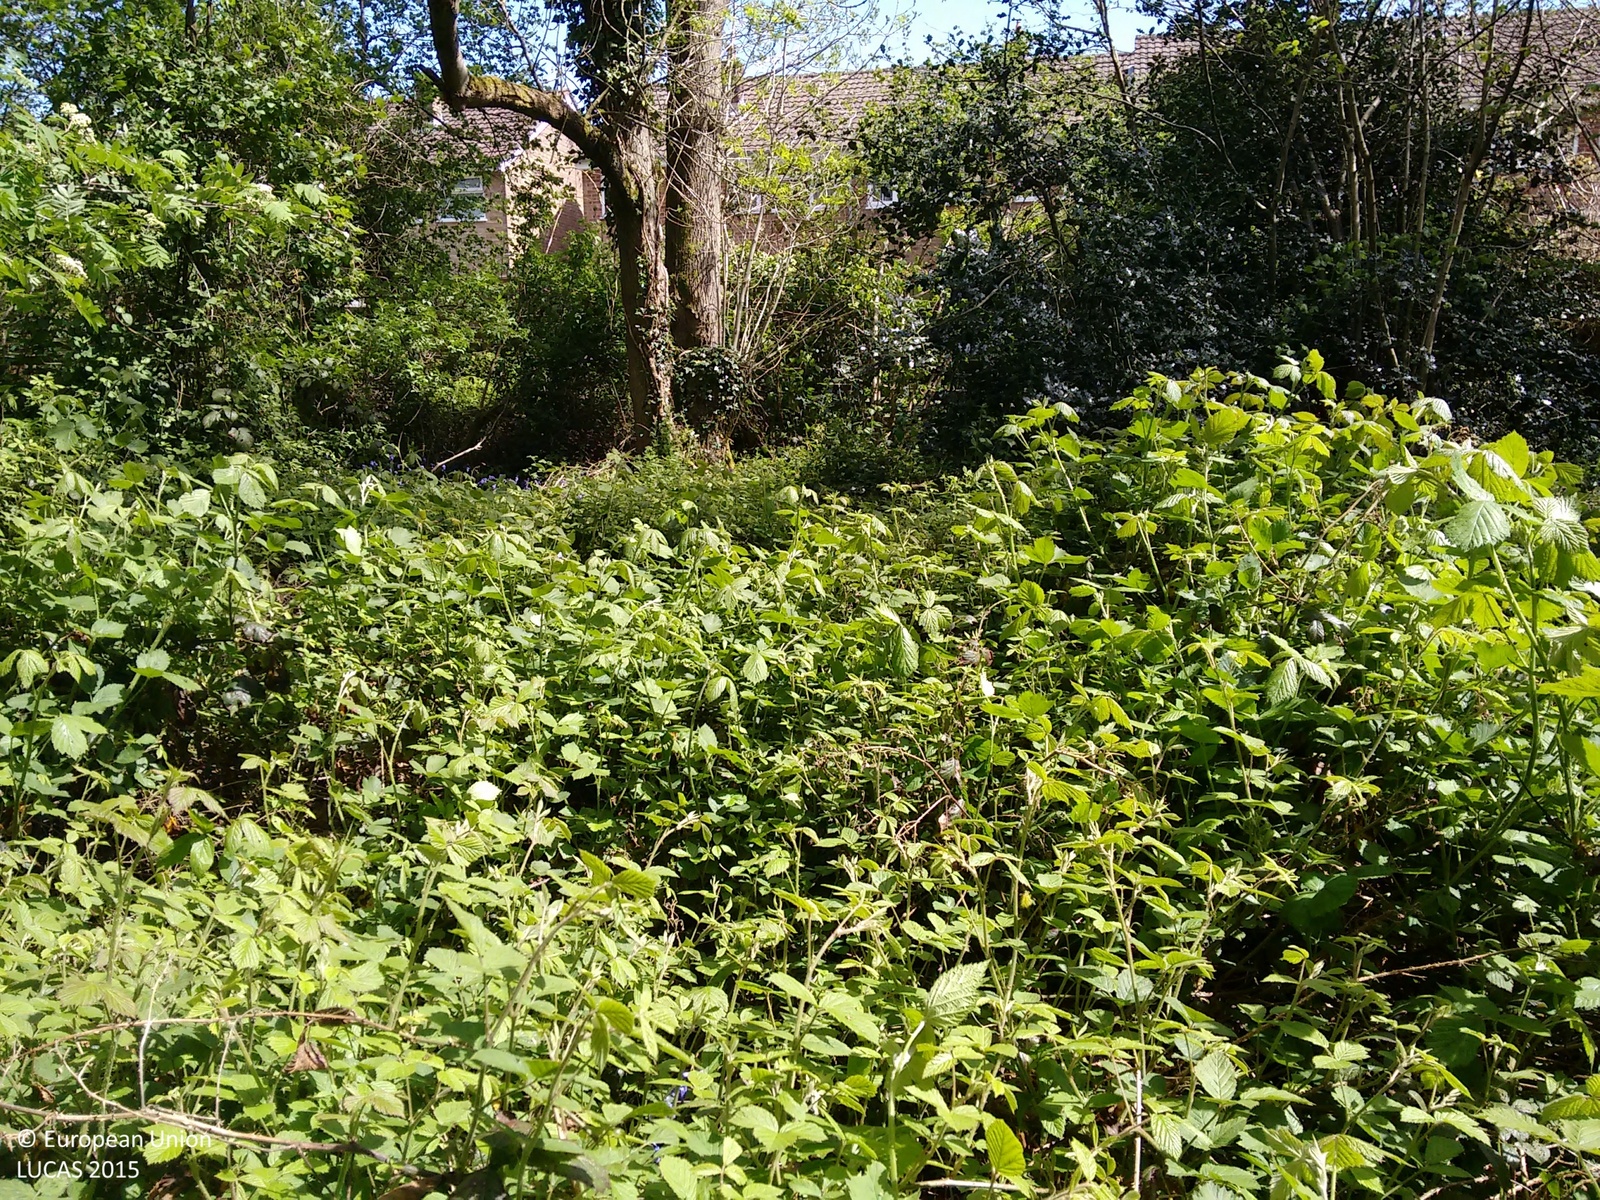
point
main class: Woodland
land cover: Broadleaved woodland
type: mesophytic deciduous forest
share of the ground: > 75 %
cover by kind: broadleaved forest trees 100 %
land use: Amenities, museums, leisure
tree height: > 5 m
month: May
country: GB
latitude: 50.8280
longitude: -1.3930
